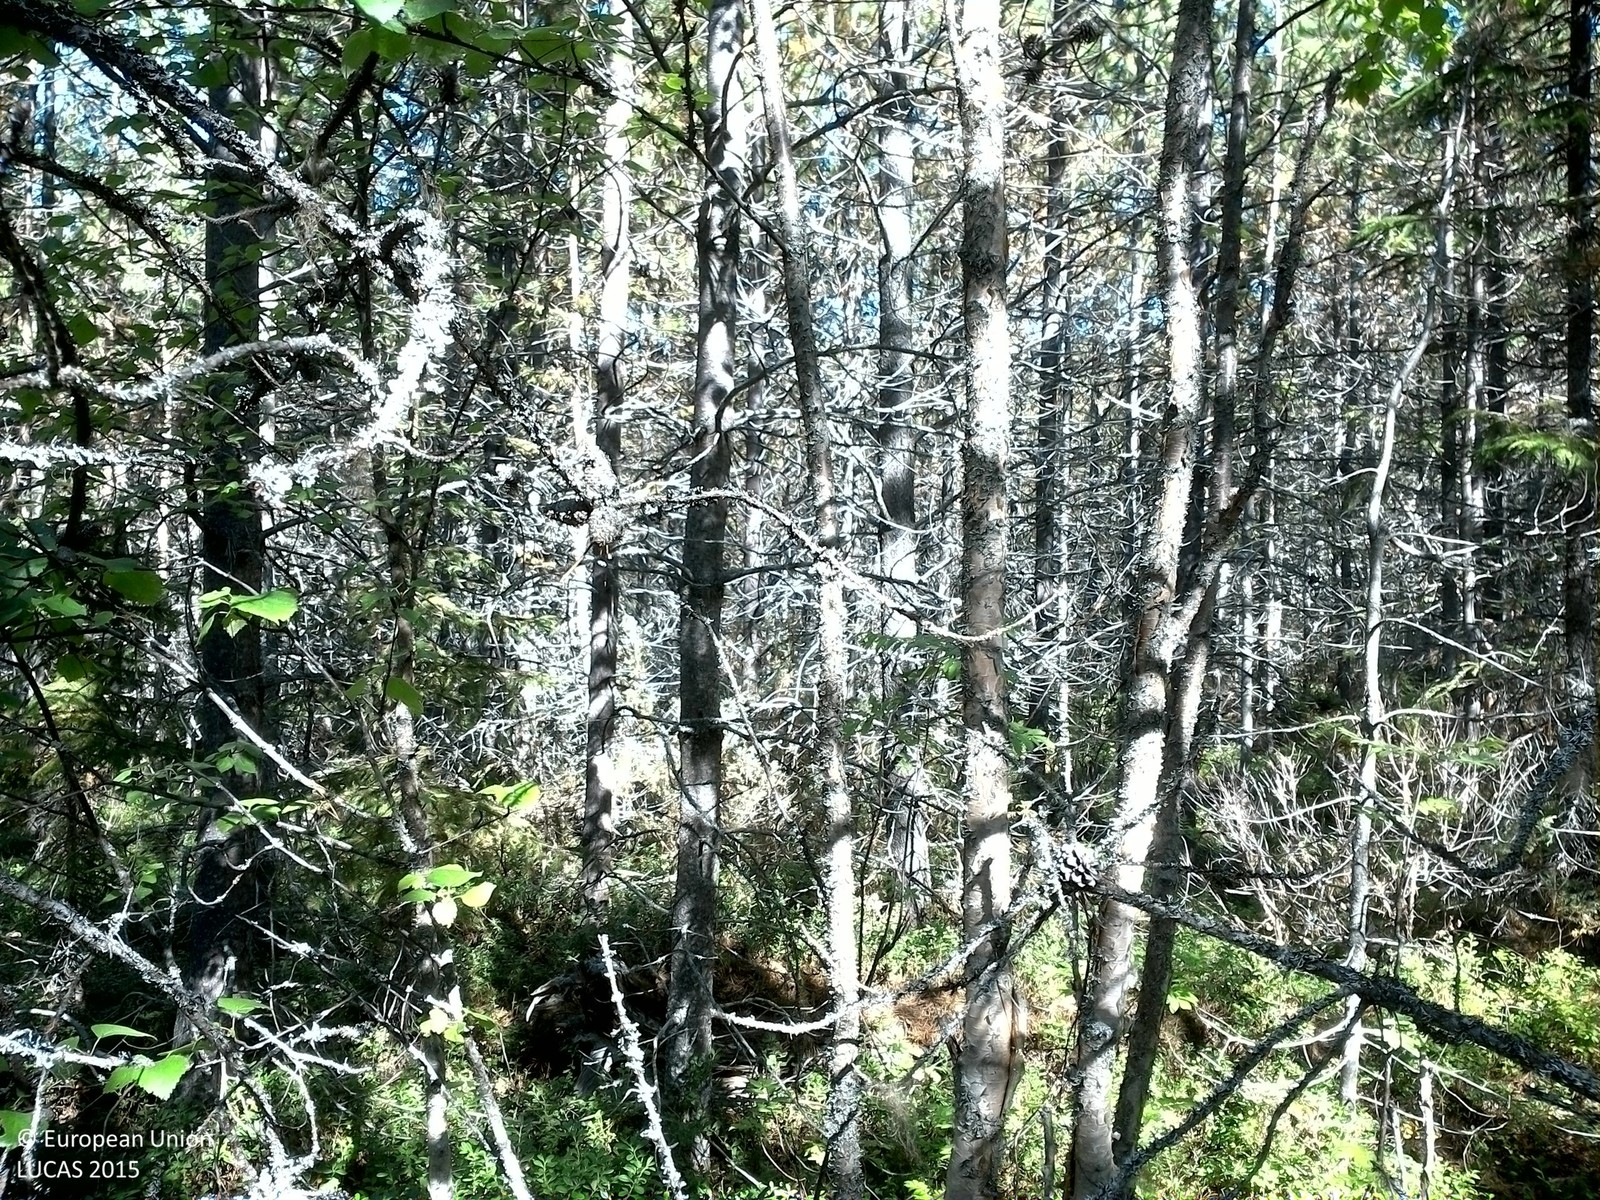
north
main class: Woodland
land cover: Pine dominated coniferous woodland
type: exotic forest
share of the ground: > 75 %
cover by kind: coniferous forest trees 80 %, shrubs 20 %
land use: Forestry
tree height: > 5 m
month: August
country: SE
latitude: 63.9267
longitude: 17.5776
